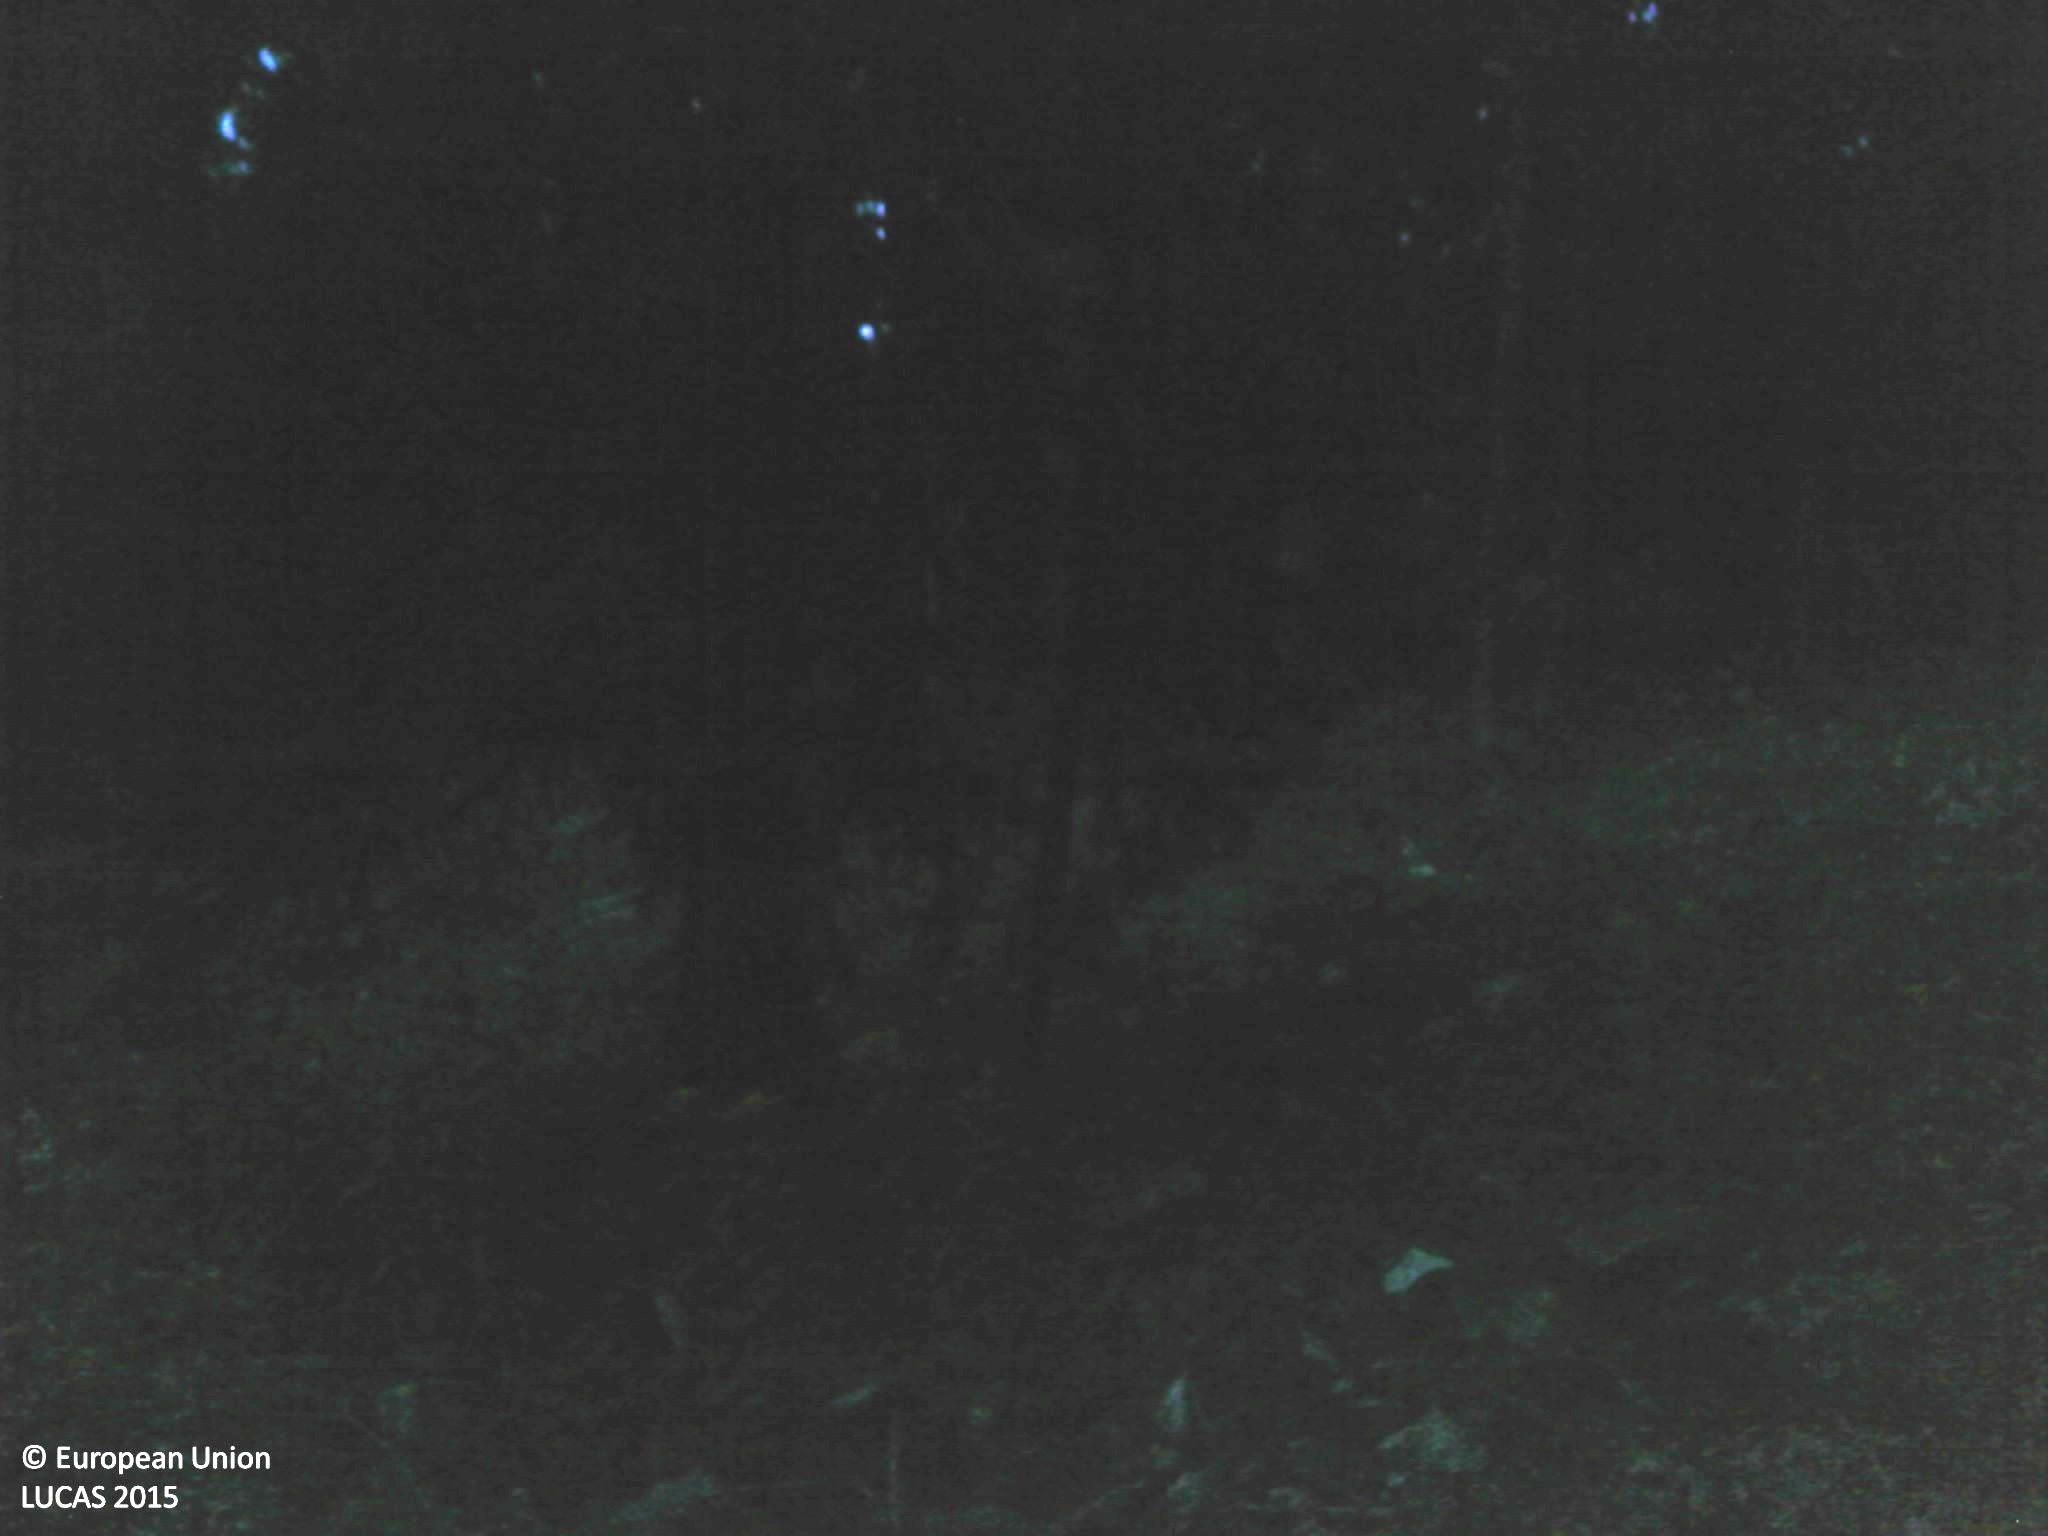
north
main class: Woodland
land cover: Spruce dominated mixed woodland
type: alpine coniferous forest
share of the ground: > 75 %
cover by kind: coniferous forest trees 60 %, broadleaved forest trees 40 %
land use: Sport
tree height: > 5 m
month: July
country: FR
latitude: 45.1957
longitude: 5.5883
